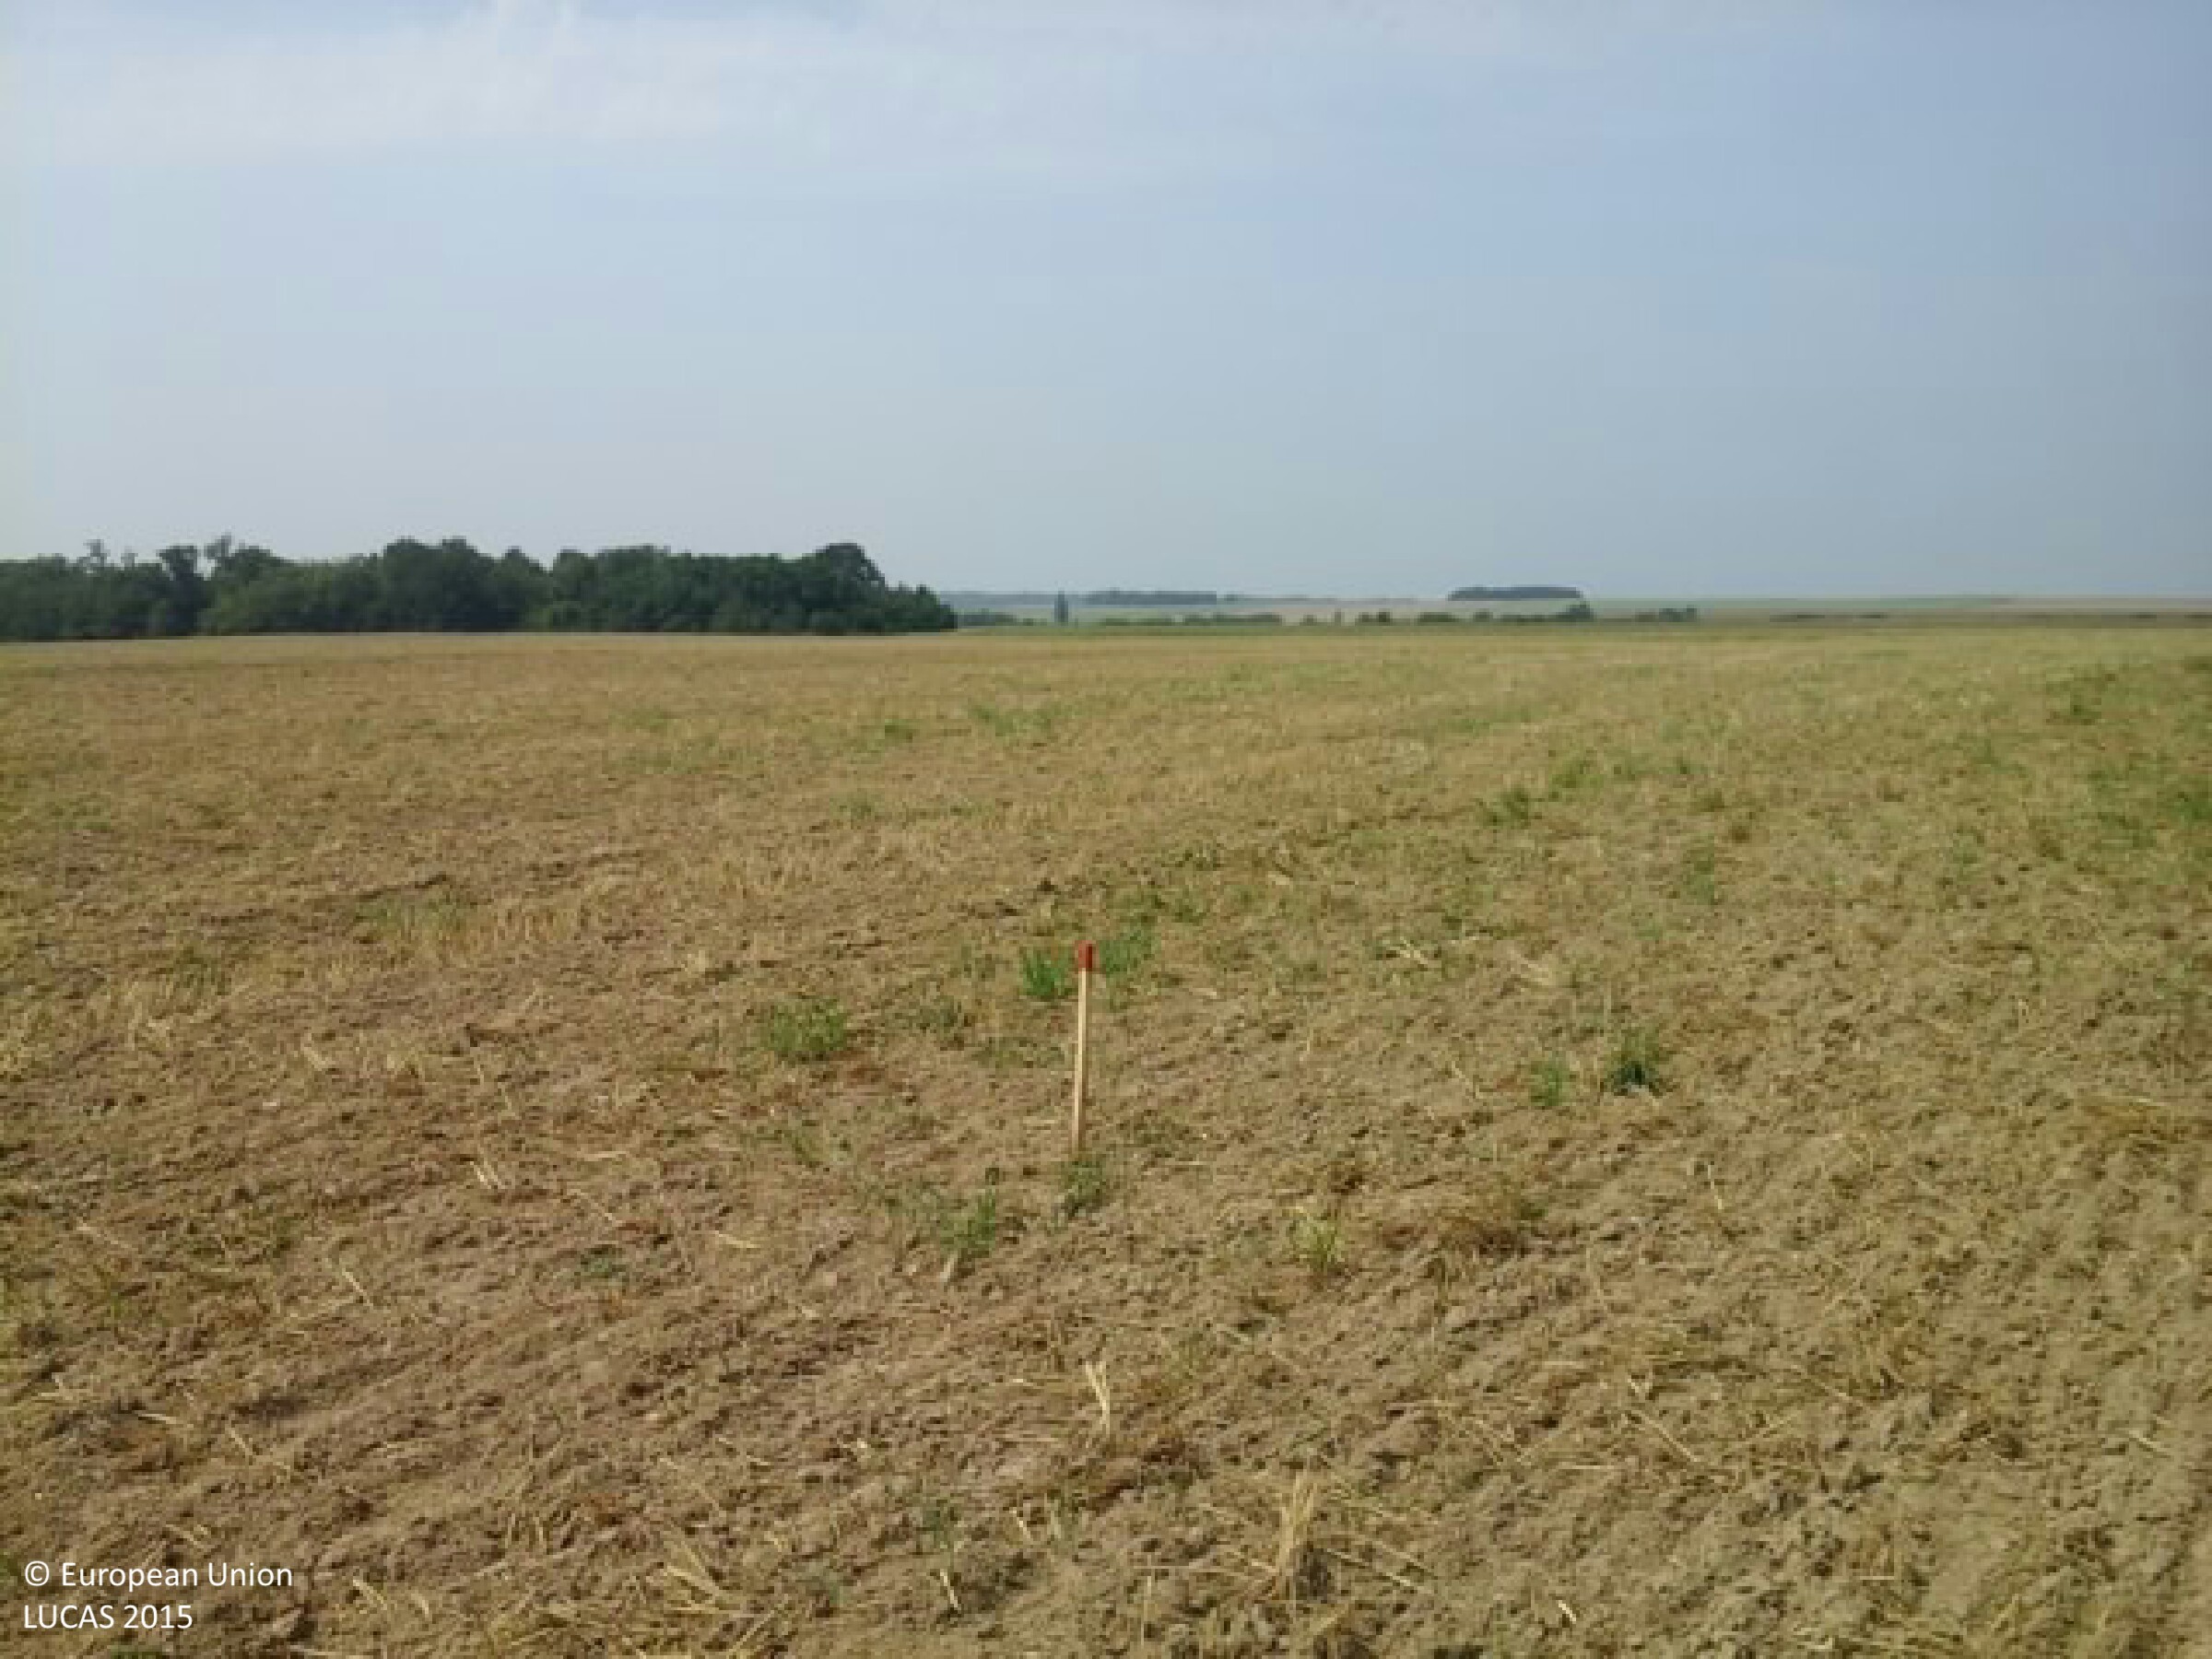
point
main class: Cropland
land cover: Common wheat
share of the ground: < 10 %
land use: Agriculture (excluding fallow land and kitchen gardens)
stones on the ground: < 10 %
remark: Harvested field
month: August
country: HU
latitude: 46.3835
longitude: 17.1414
